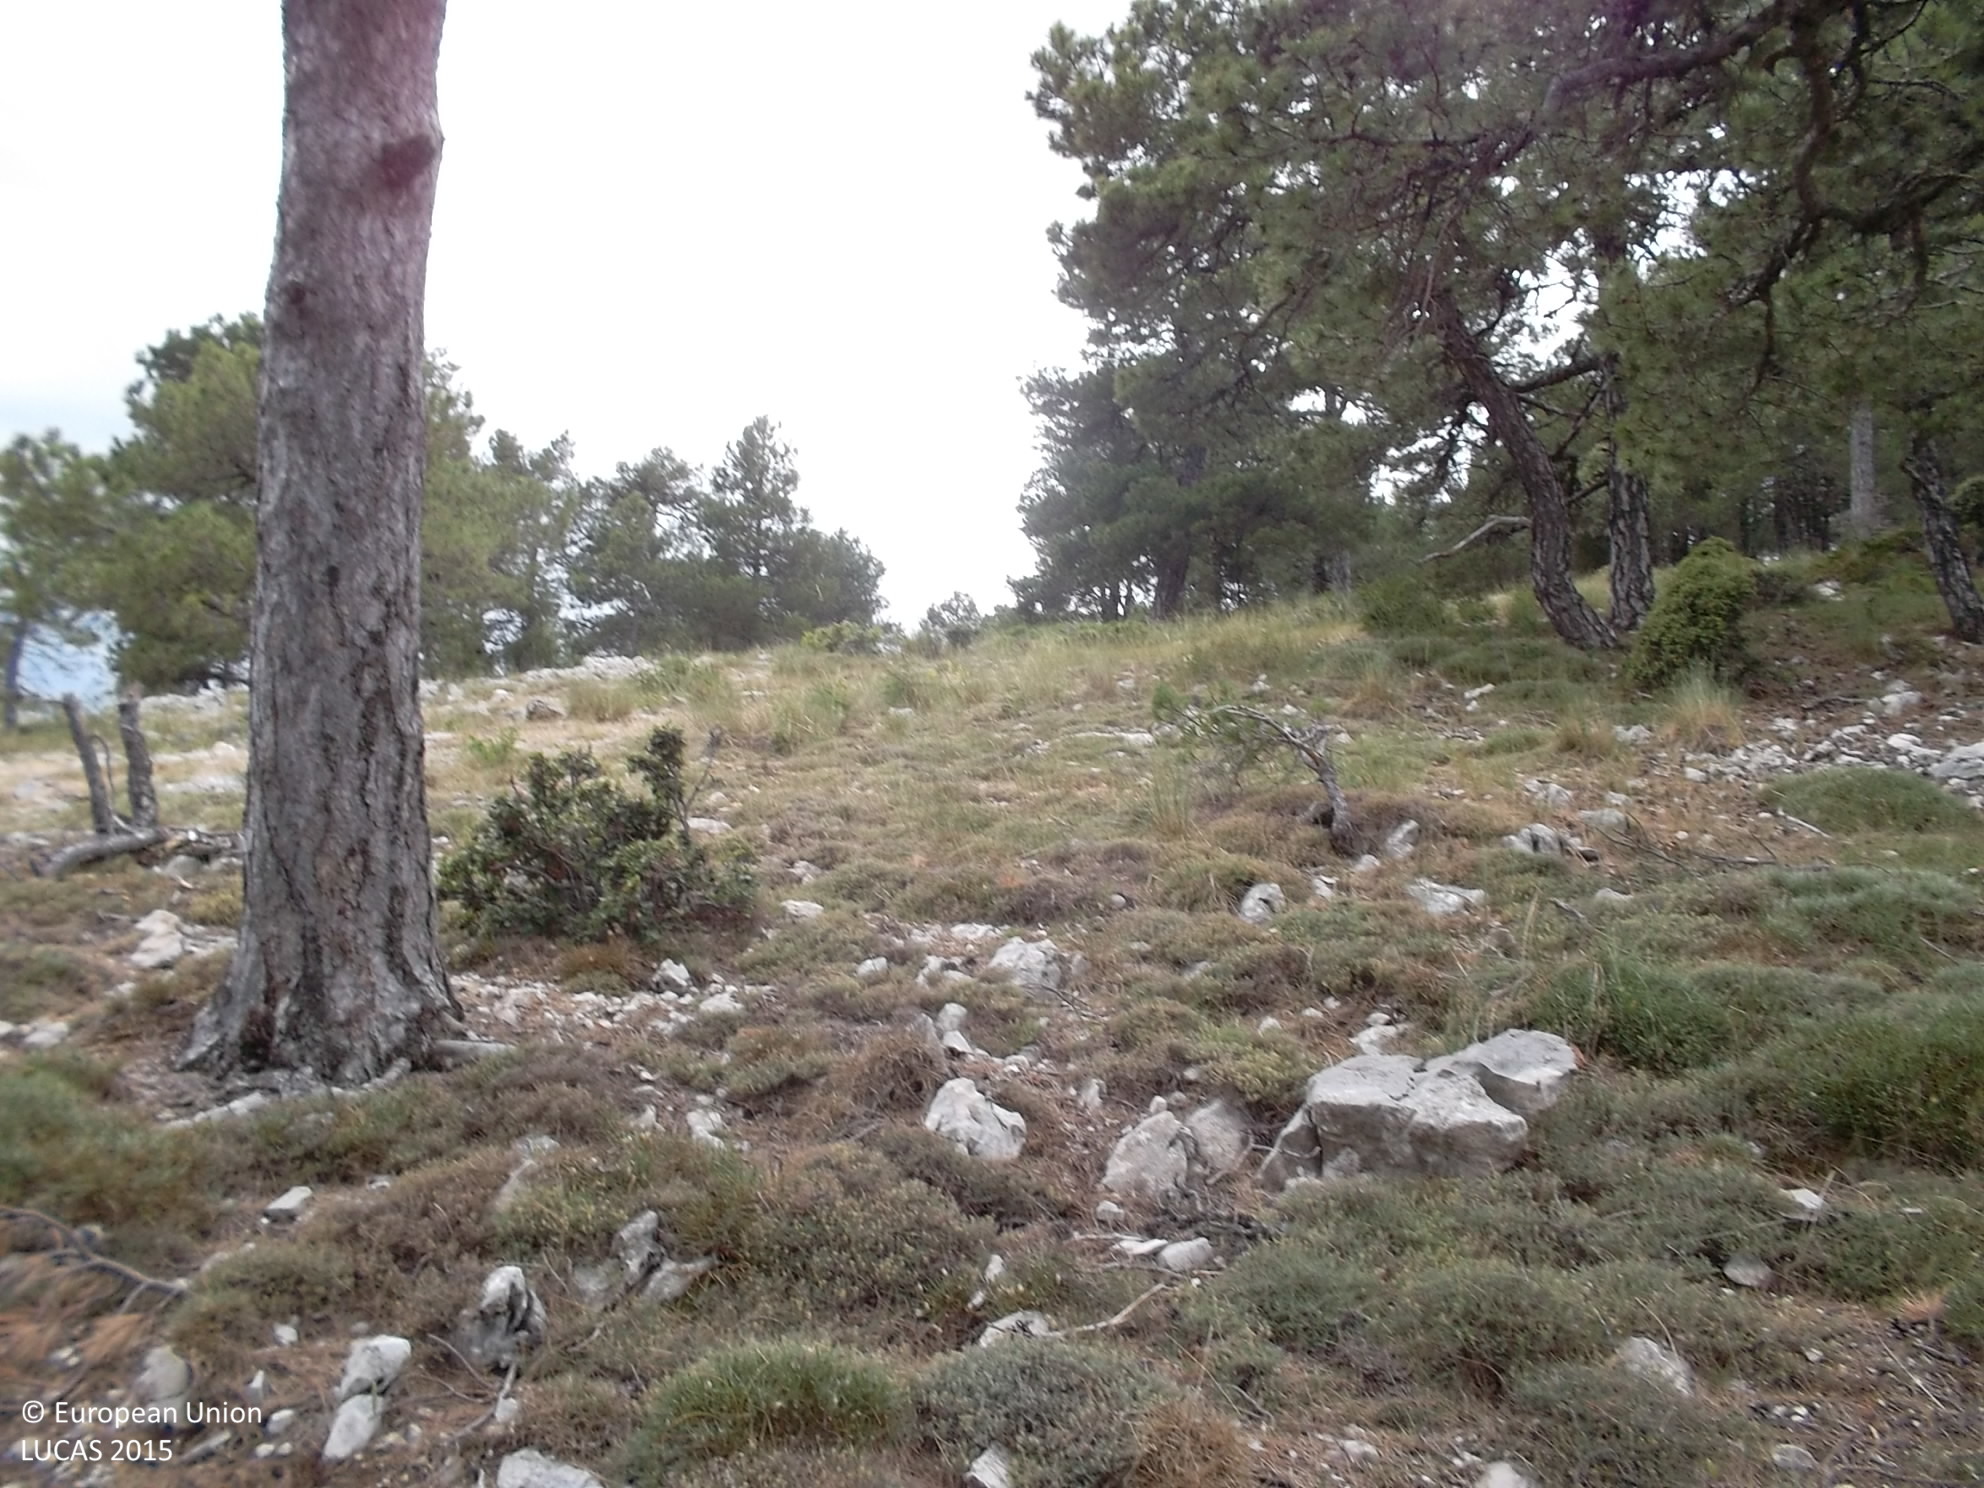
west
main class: Woodland
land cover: Pine dominated coniferous woodland
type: coniferous forest of the mediterranean region
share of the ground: 50 - 75 %
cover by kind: coniferous forest trees 60 %, herbaceous plants 20 %, consolidated bare surface 20 %
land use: Forestry
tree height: > 5 m
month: June
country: ES
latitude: 37.7902
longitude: -2.9726
